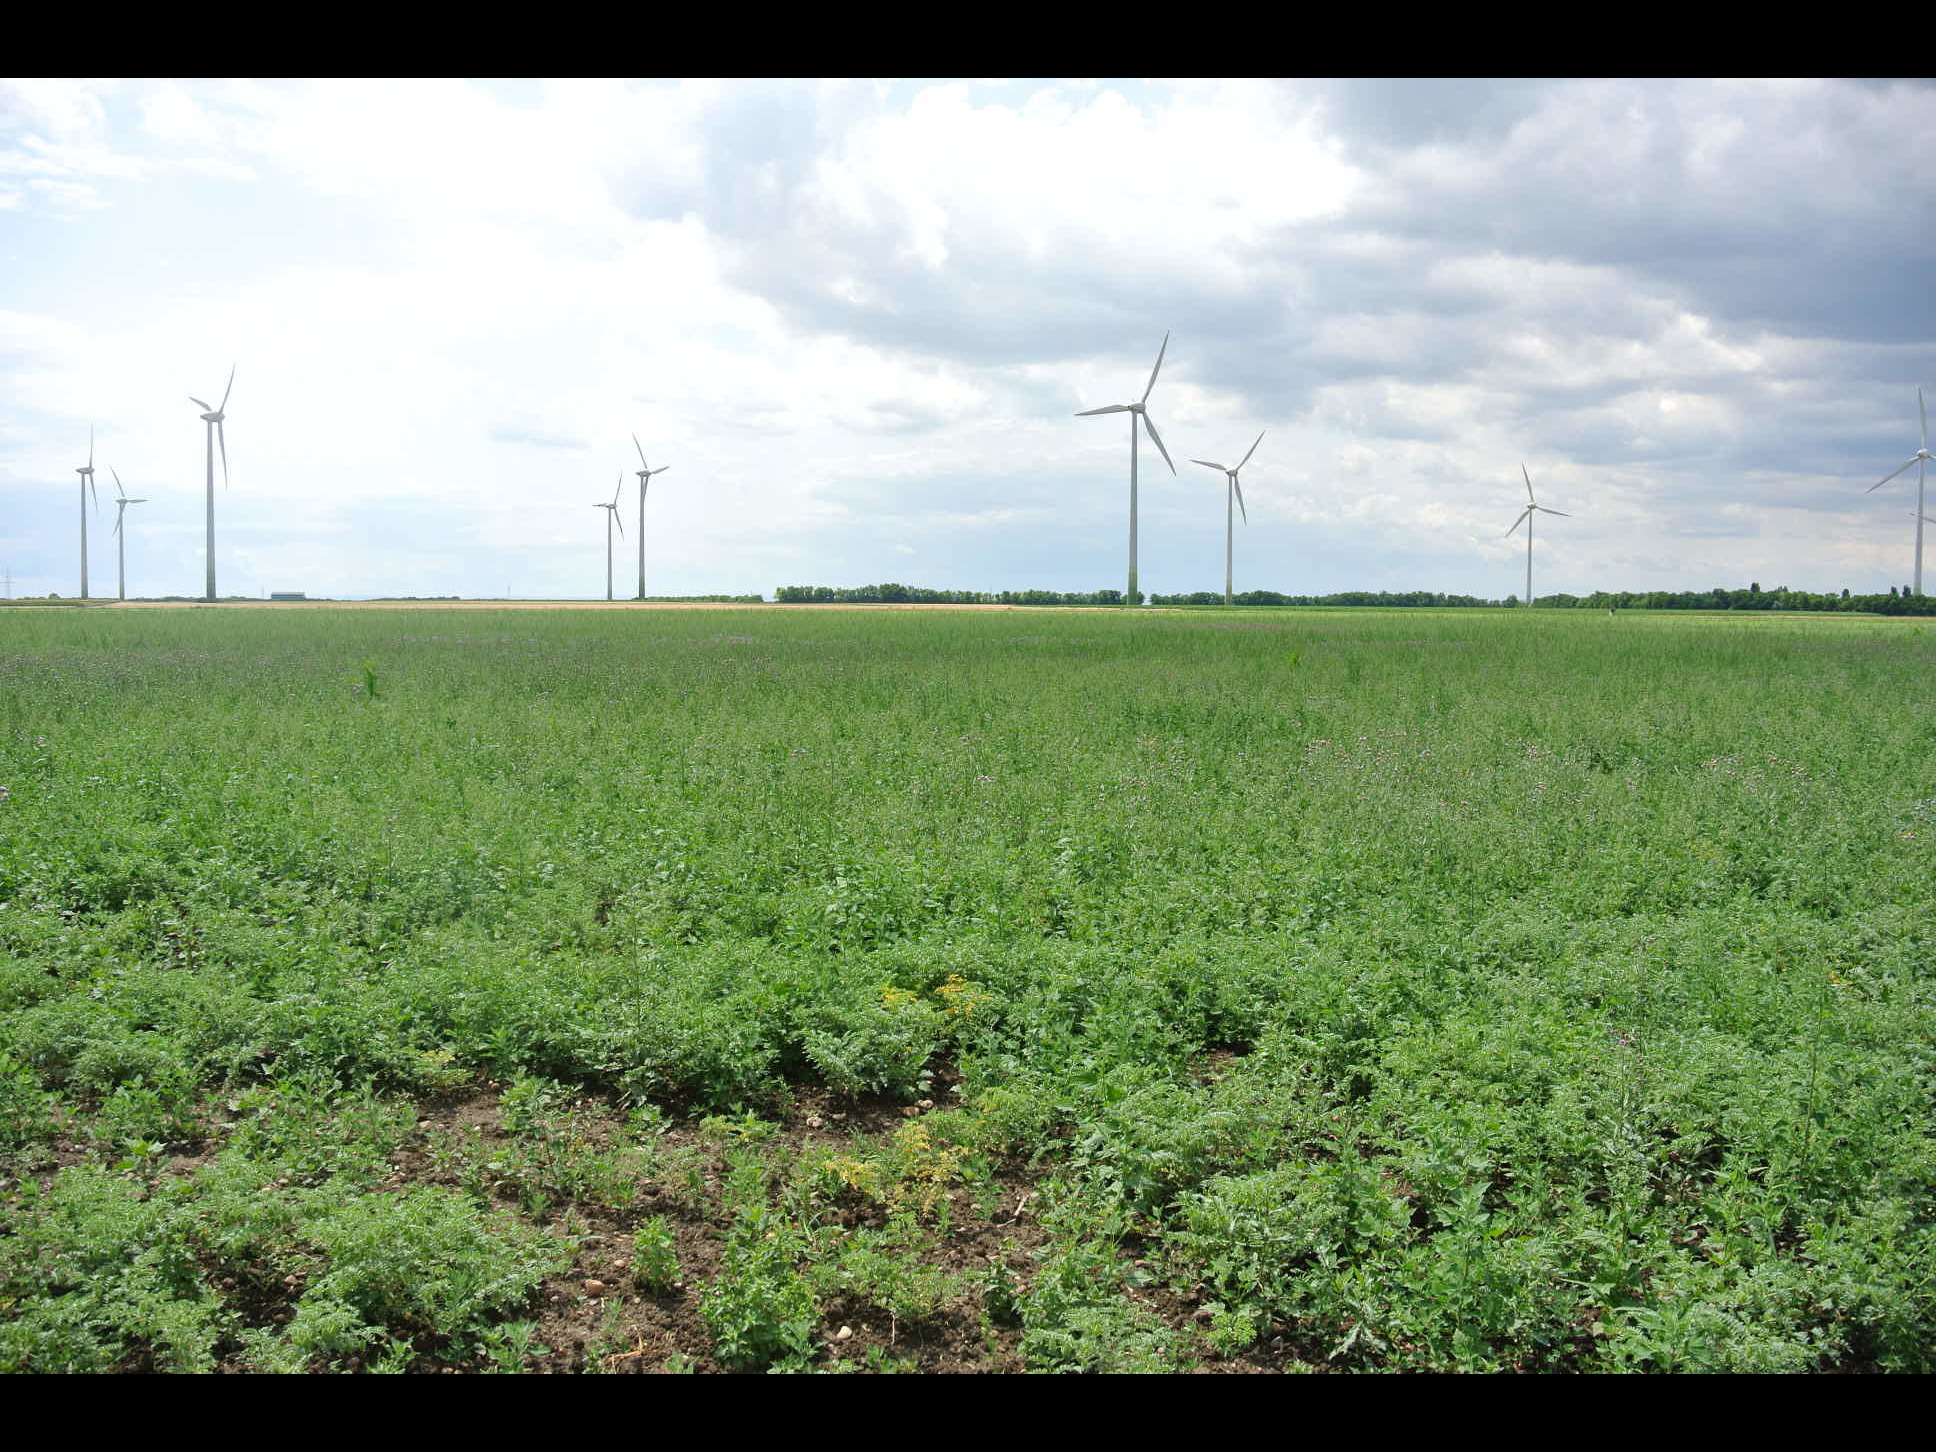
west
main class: Cropland
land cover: Dry pulses
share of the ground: > 75 %
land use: Agriculture (excluding fallow land and kitchen gardens)
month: July
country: AT
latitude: 47.9529
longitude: 16.9026
